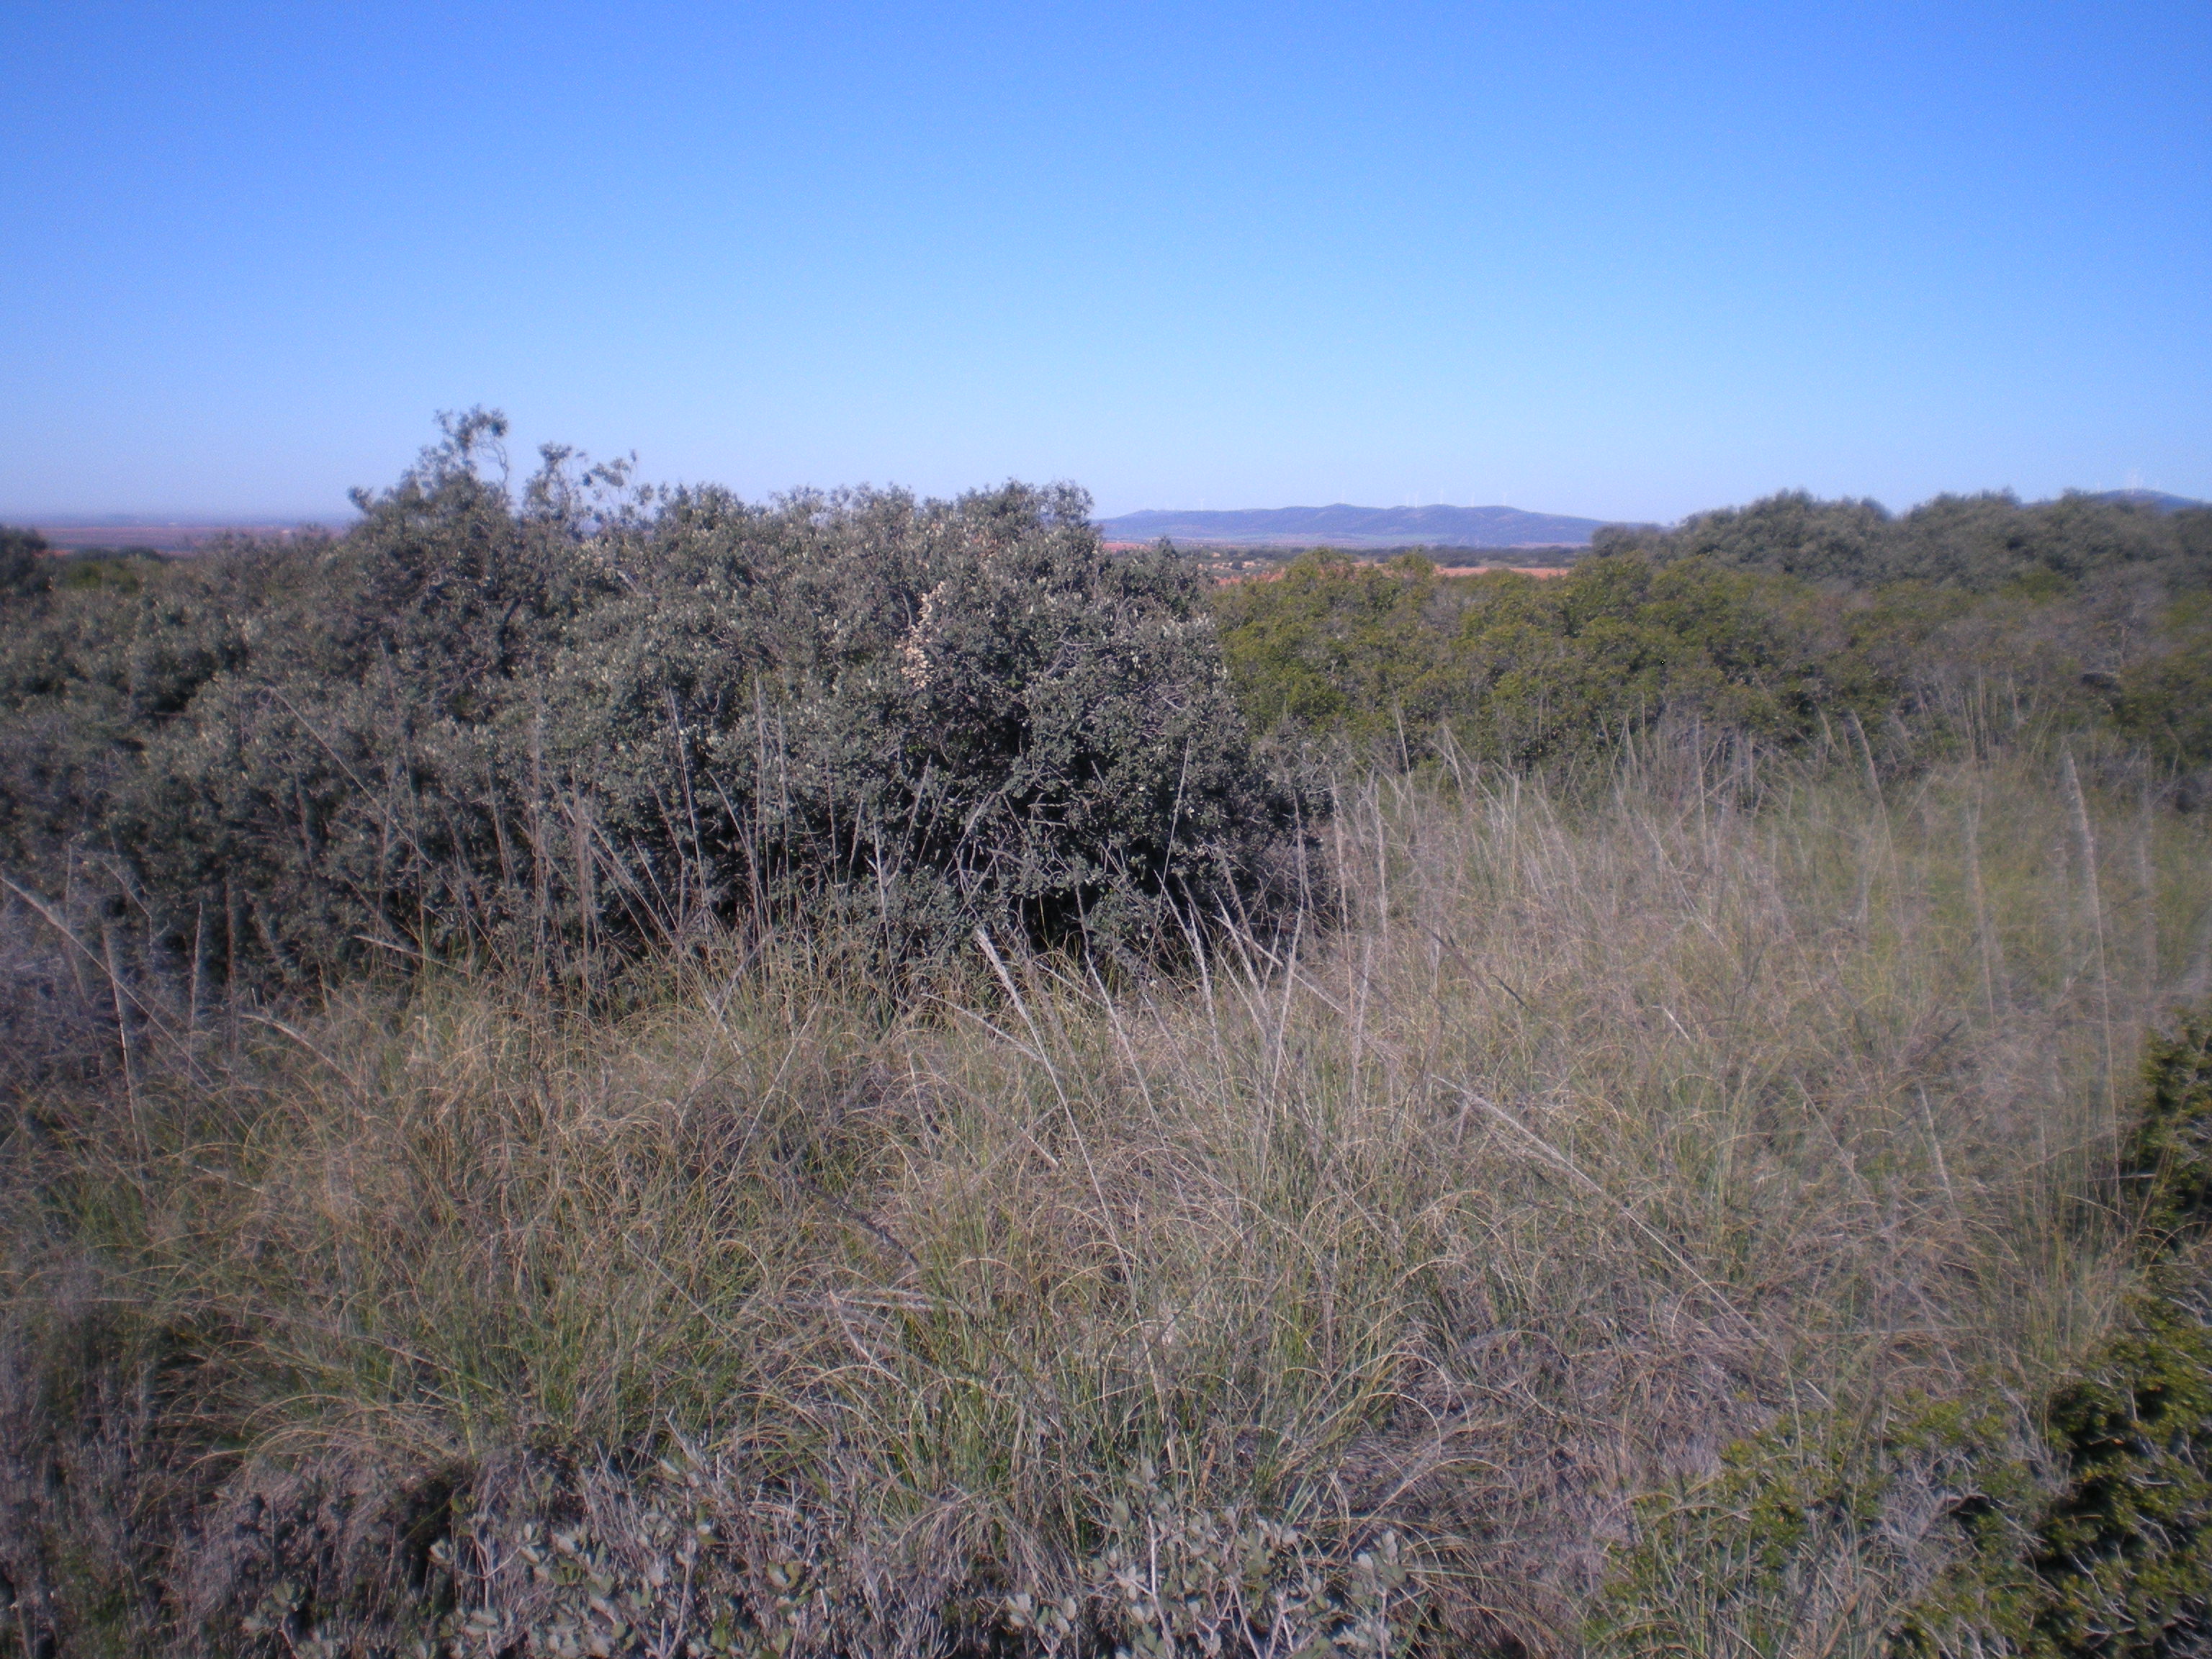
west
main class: Woodland
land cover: Broadleaved woodland
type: broadleaved evergreen forest
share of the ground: 25 - 50 %
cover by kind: shrubs 50 %, broadleaved forest trees 25 %, consolidated bare surface 20 %, herbaceous plants 5 %
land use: Semi-natural and natural areas not in use
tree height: < 5 m
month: April
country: ES
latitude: 38.8290
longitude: -3.0131
